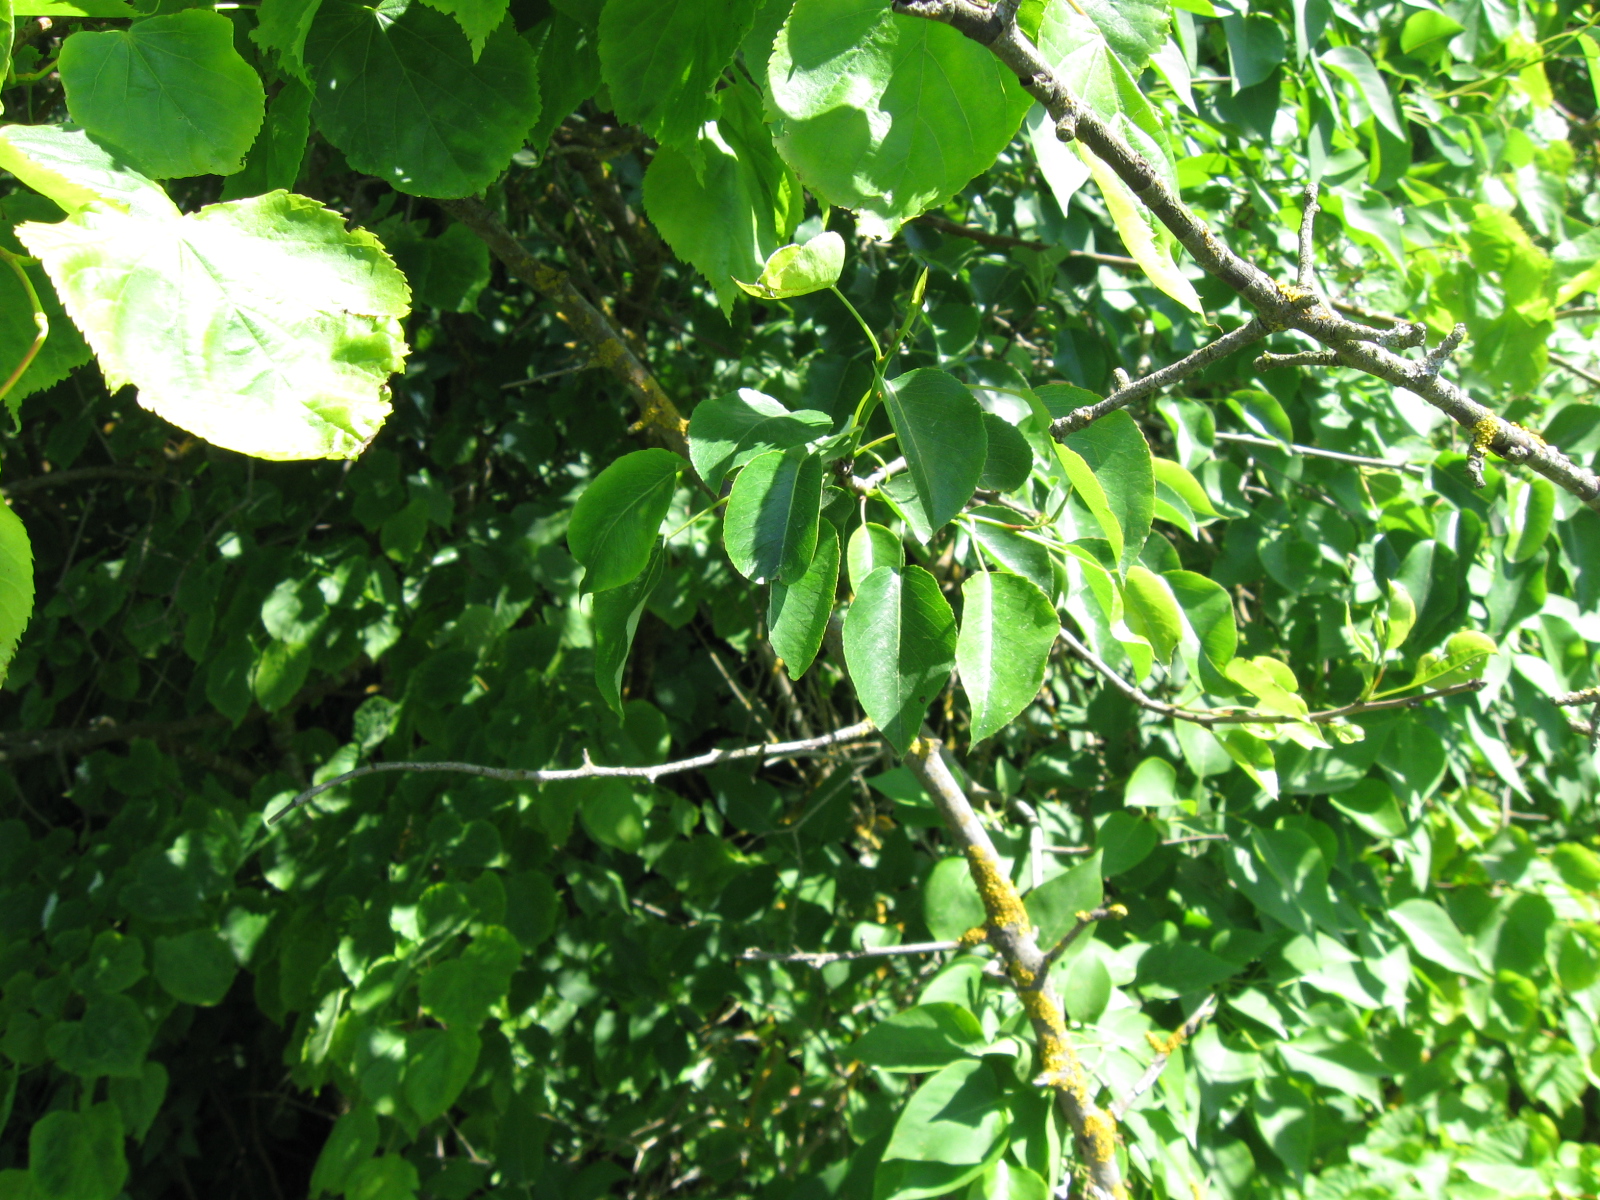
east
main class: Woodland
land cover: Broadleaved woodland
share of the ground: 25 - 50 %
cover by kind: broadleaved forest trees 45 %, herbaceous plants 40 %, shrubs 15 %
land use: Forestry
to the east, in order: Broadleaved woodland; Barley; Artificial constructions in urban areas; Grassland without tree/shrub cover; Barley; Grass margins; Dry pulses; Grassland without tree/shrub cover
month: June
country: LT
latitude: 54.0949
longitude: 23.5547
